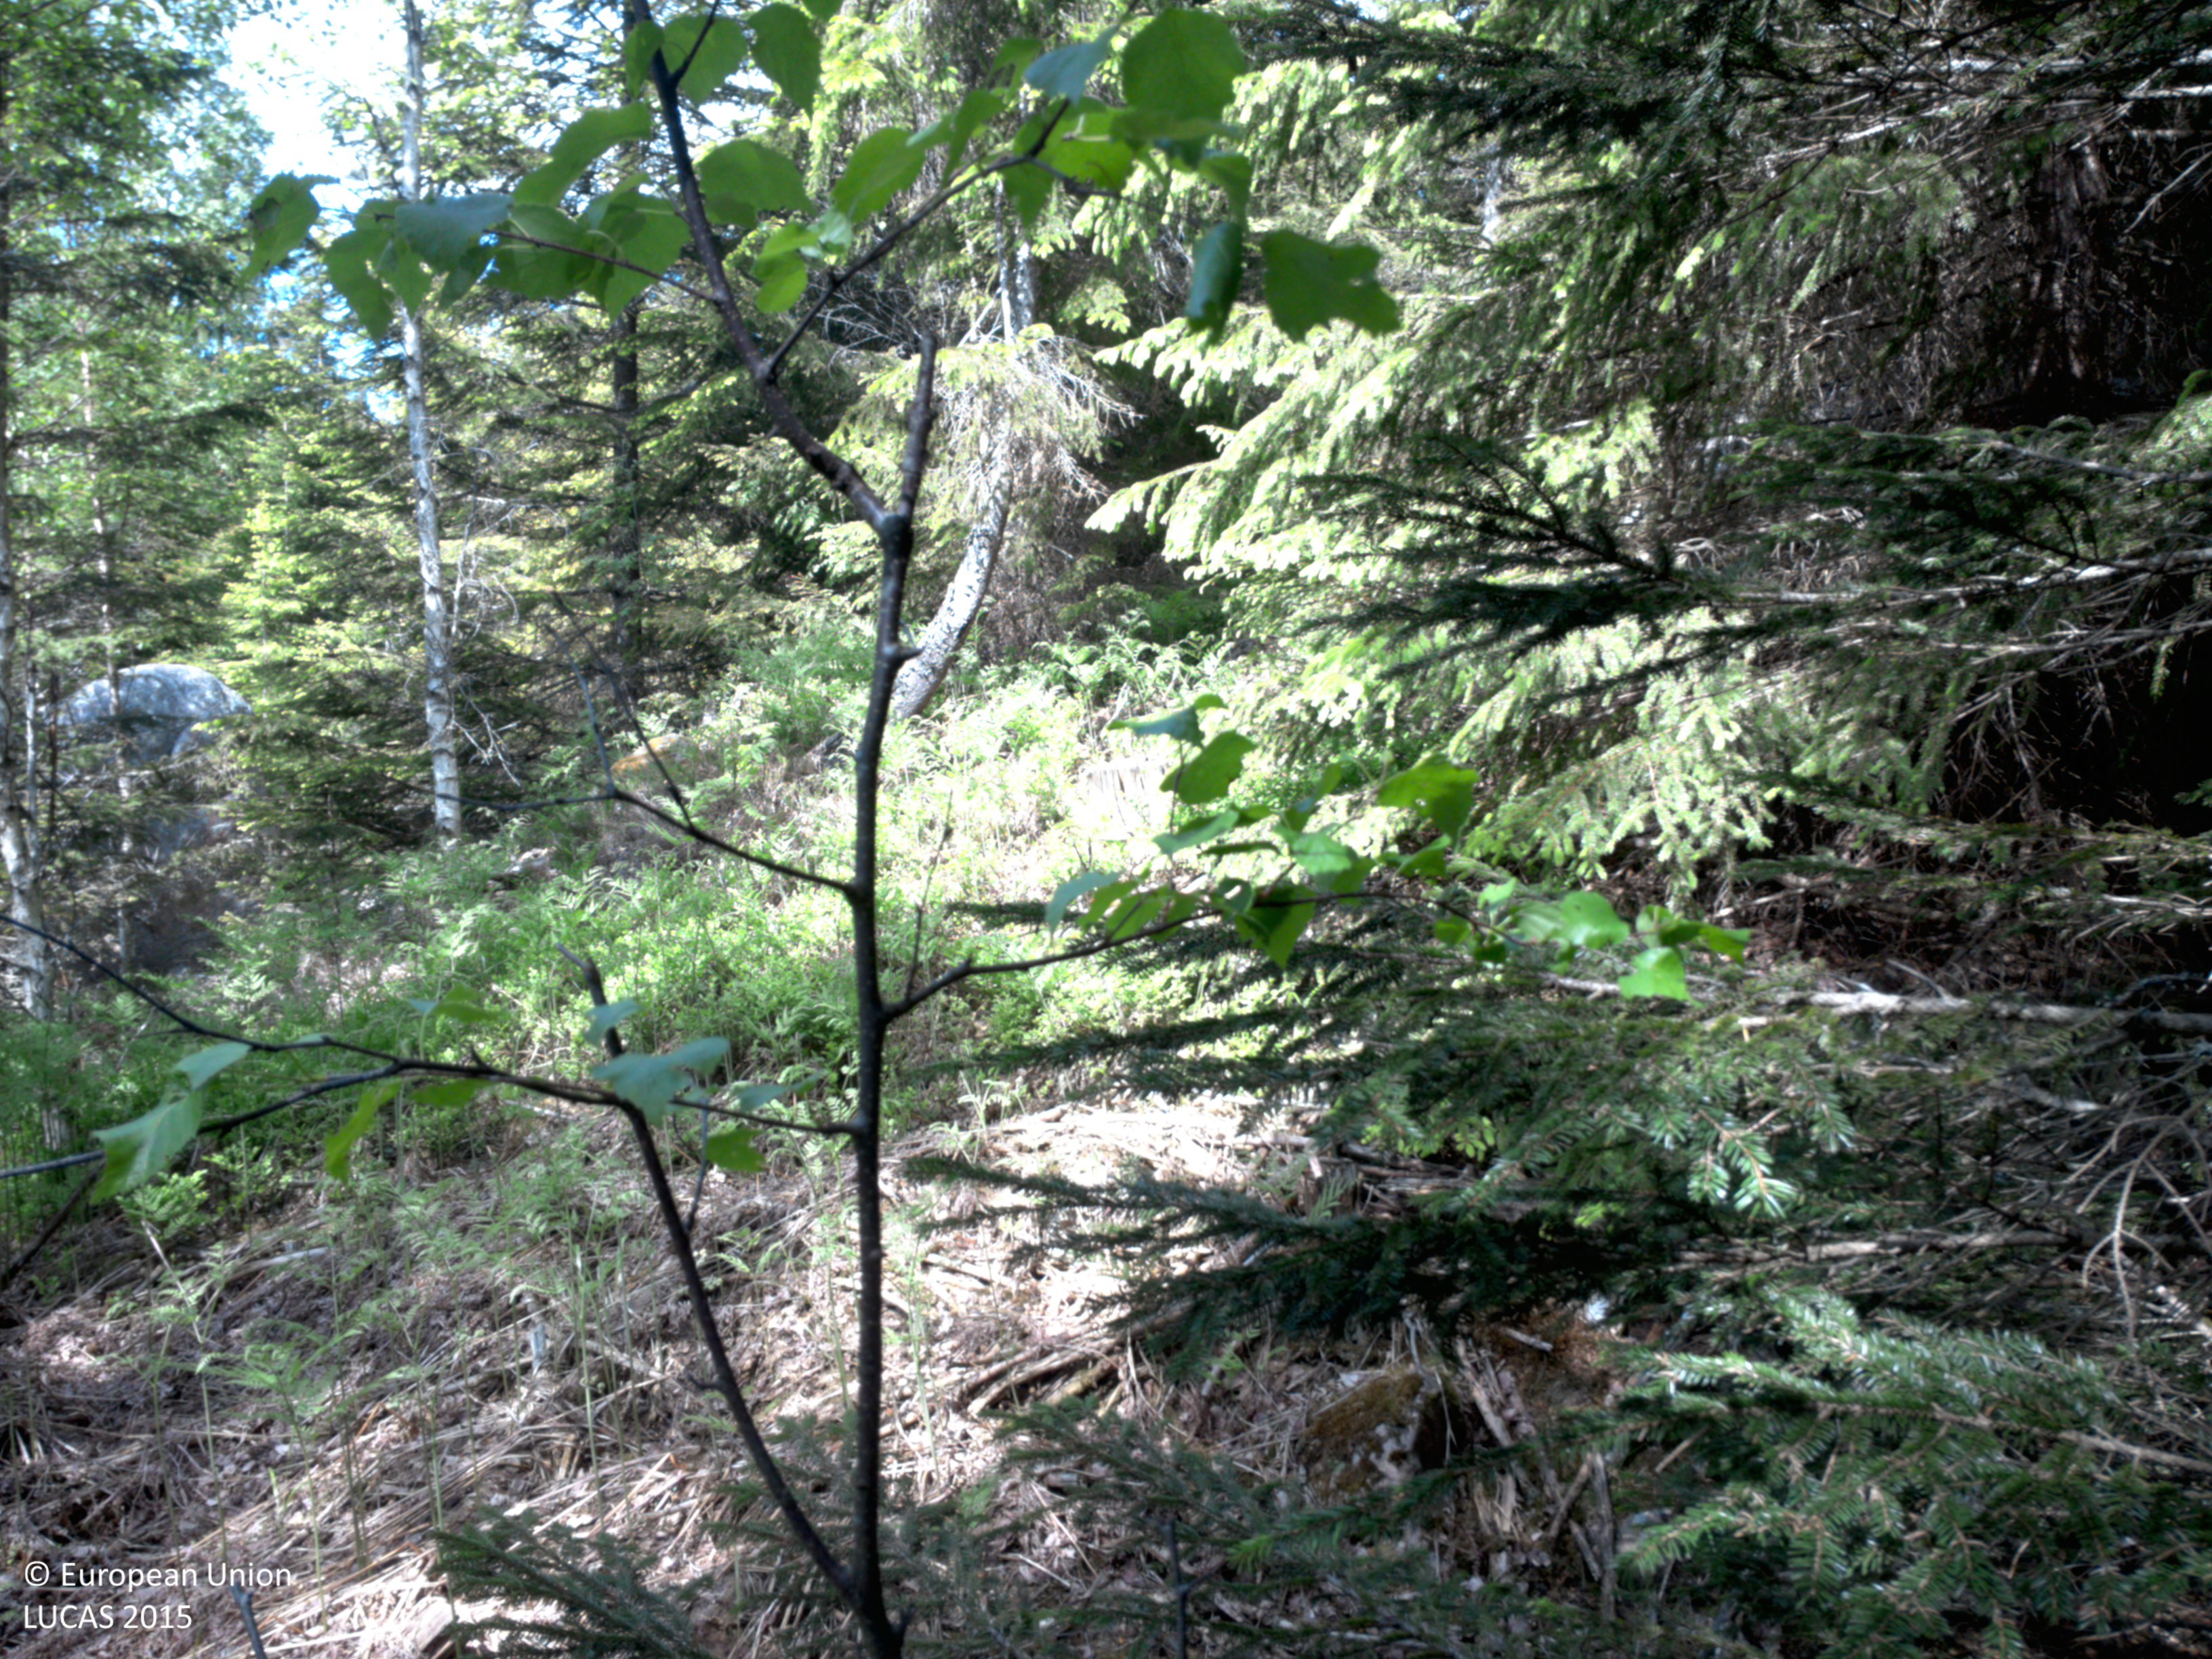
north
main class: Woodland
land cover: Spruce dominated mixed woodland
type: boreal forest
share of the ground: > 75 %
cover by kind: coniferous forest trees 55 %, broadleaved forest trees 25 %, lichens and mosses 15 %, shrubs 5 %
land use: Forestry
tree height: > 5 m
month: June
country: SE
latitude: 59.0802
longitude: 12.3848
